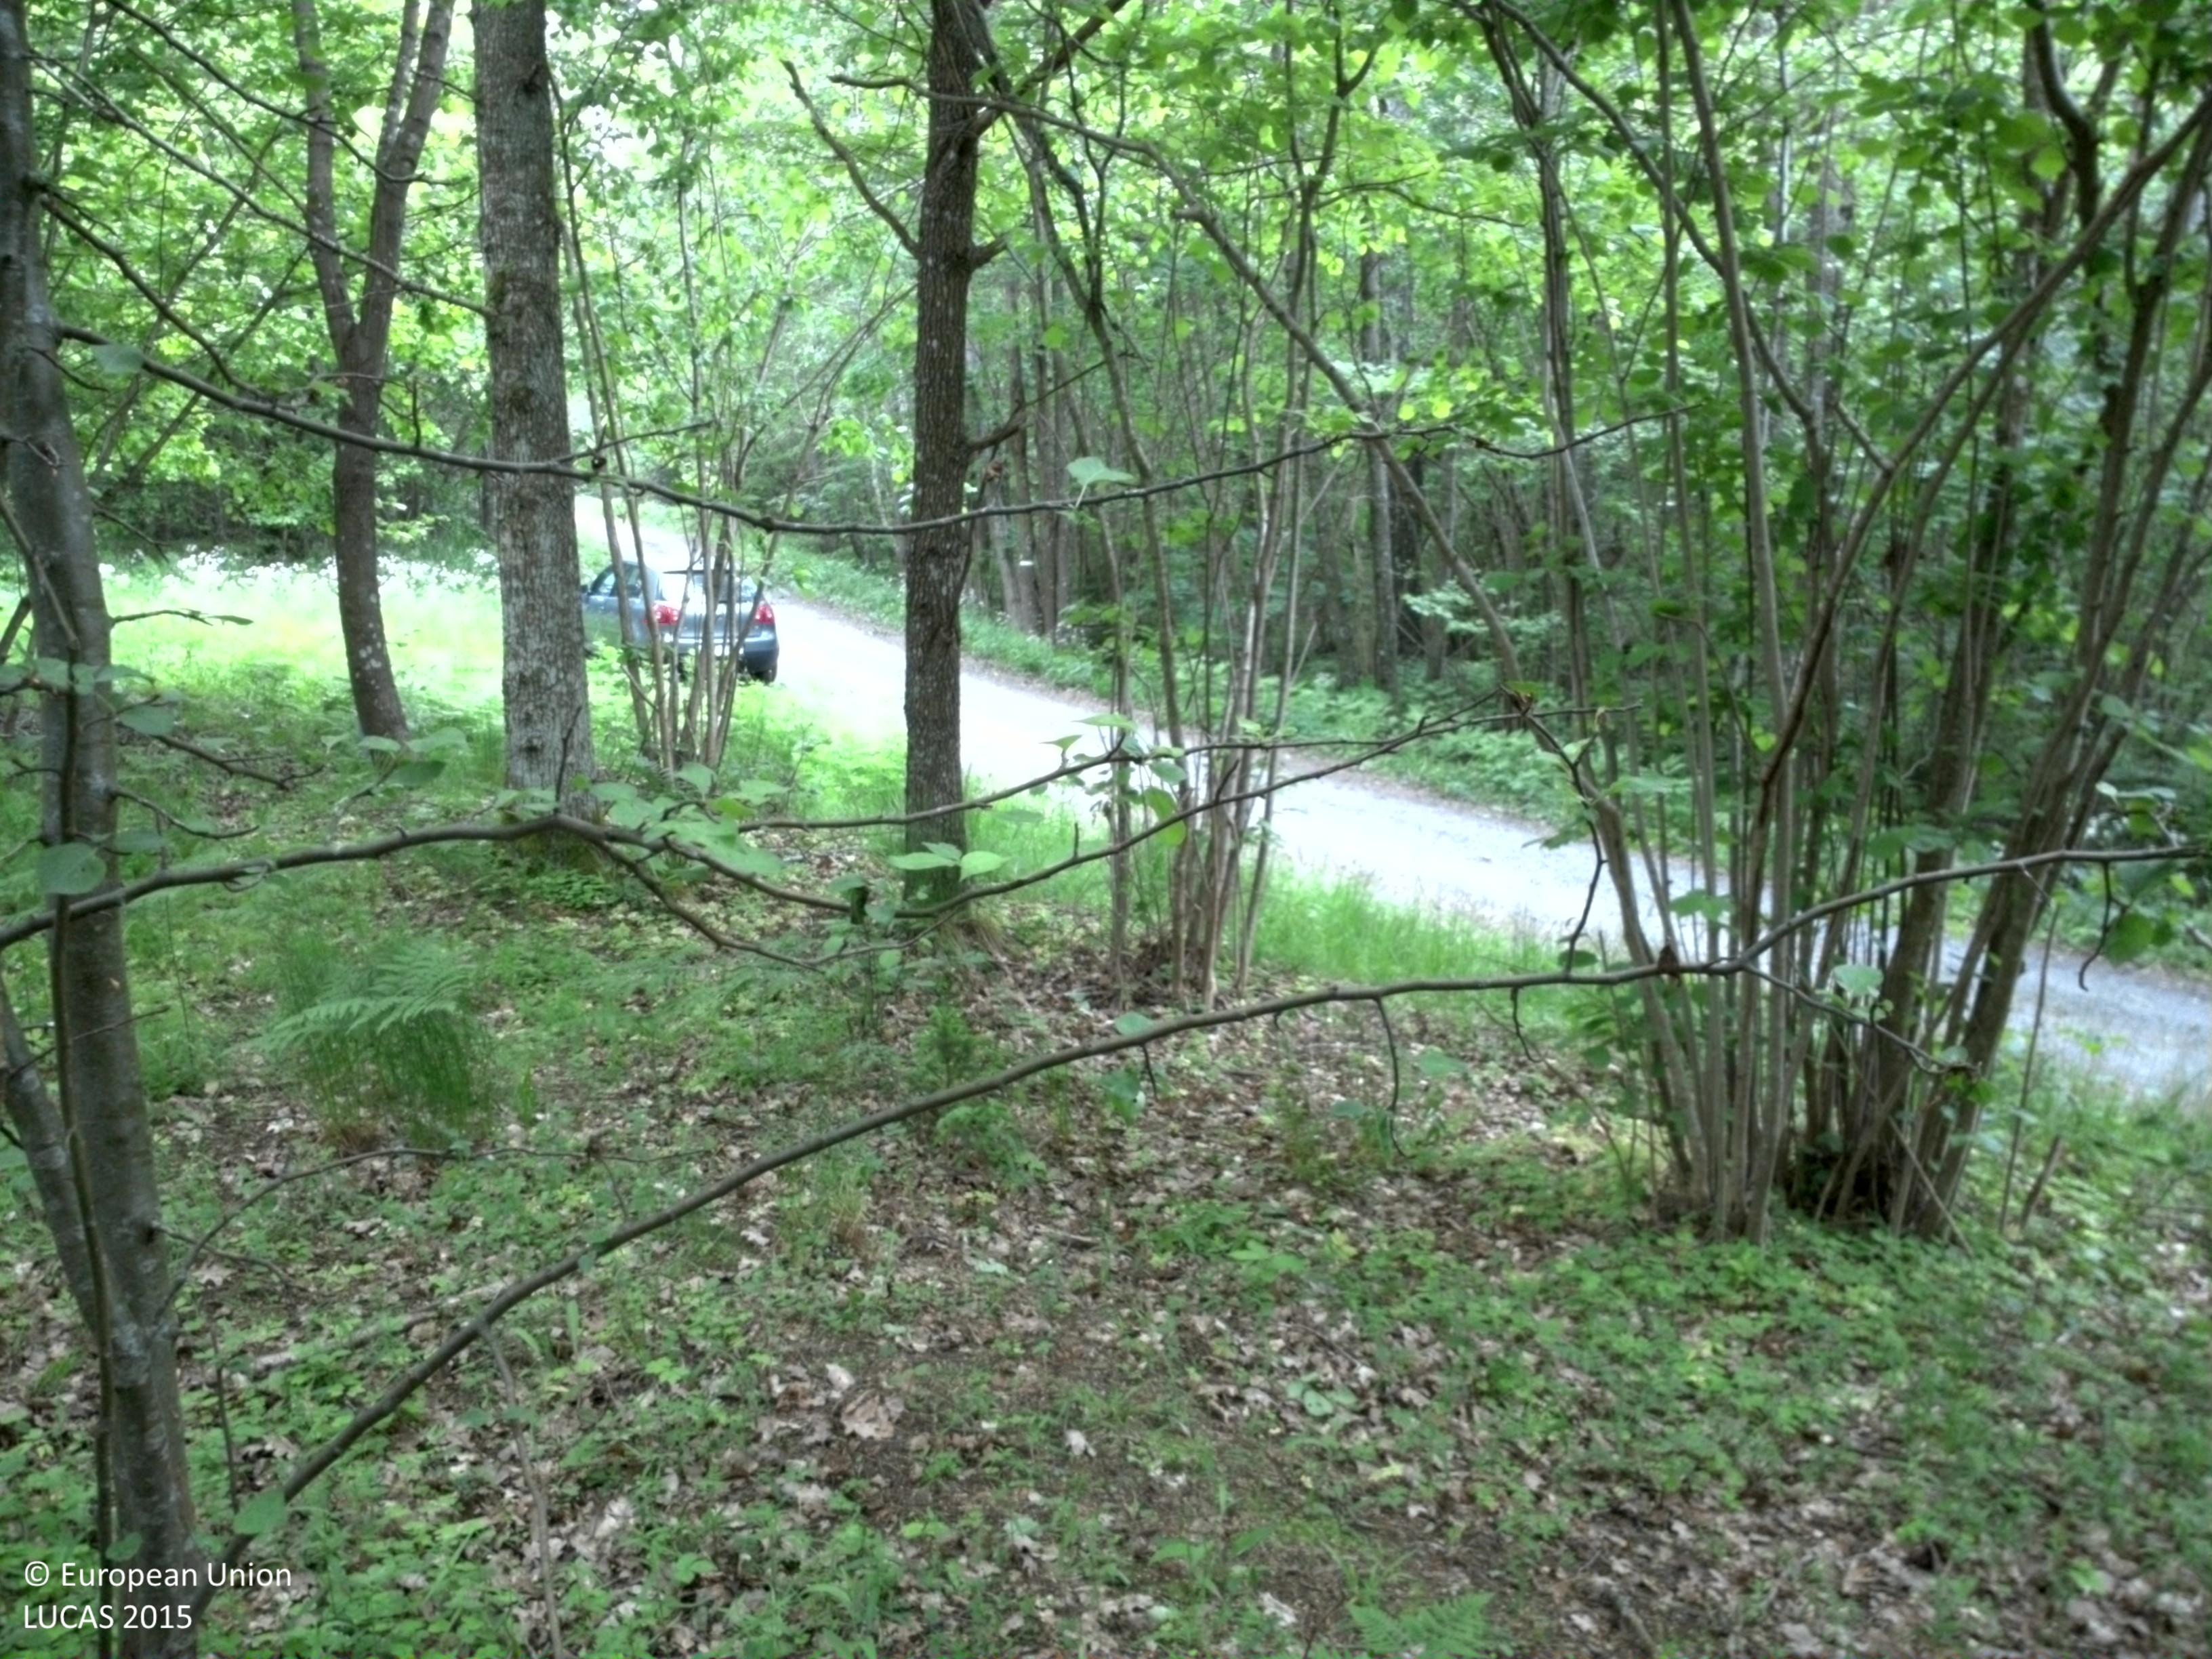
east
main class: Woodland
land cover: Broadleaved woodland
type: hemiboreal forest and nemoral coniferous forest and mixed broadleaved-coniferous forest
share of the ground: 50 - 75 %
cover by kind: broadleaved forest trees 70 %, herbaceous plants 30 %
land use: Forestry
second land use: Amenities, museums, leisure
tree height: > 5 m
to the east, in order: Broadleaved woodland; Paved roads, cycling and walking lanes; Ditches and canals; Broadleaved woodland; Pine dominated mixed woodland; Broadleaved woodland; Pine dominated mixed woodland; Pine dominated coniferous woodland
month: June
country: SE
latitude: 58.6712
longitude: 16.2197
